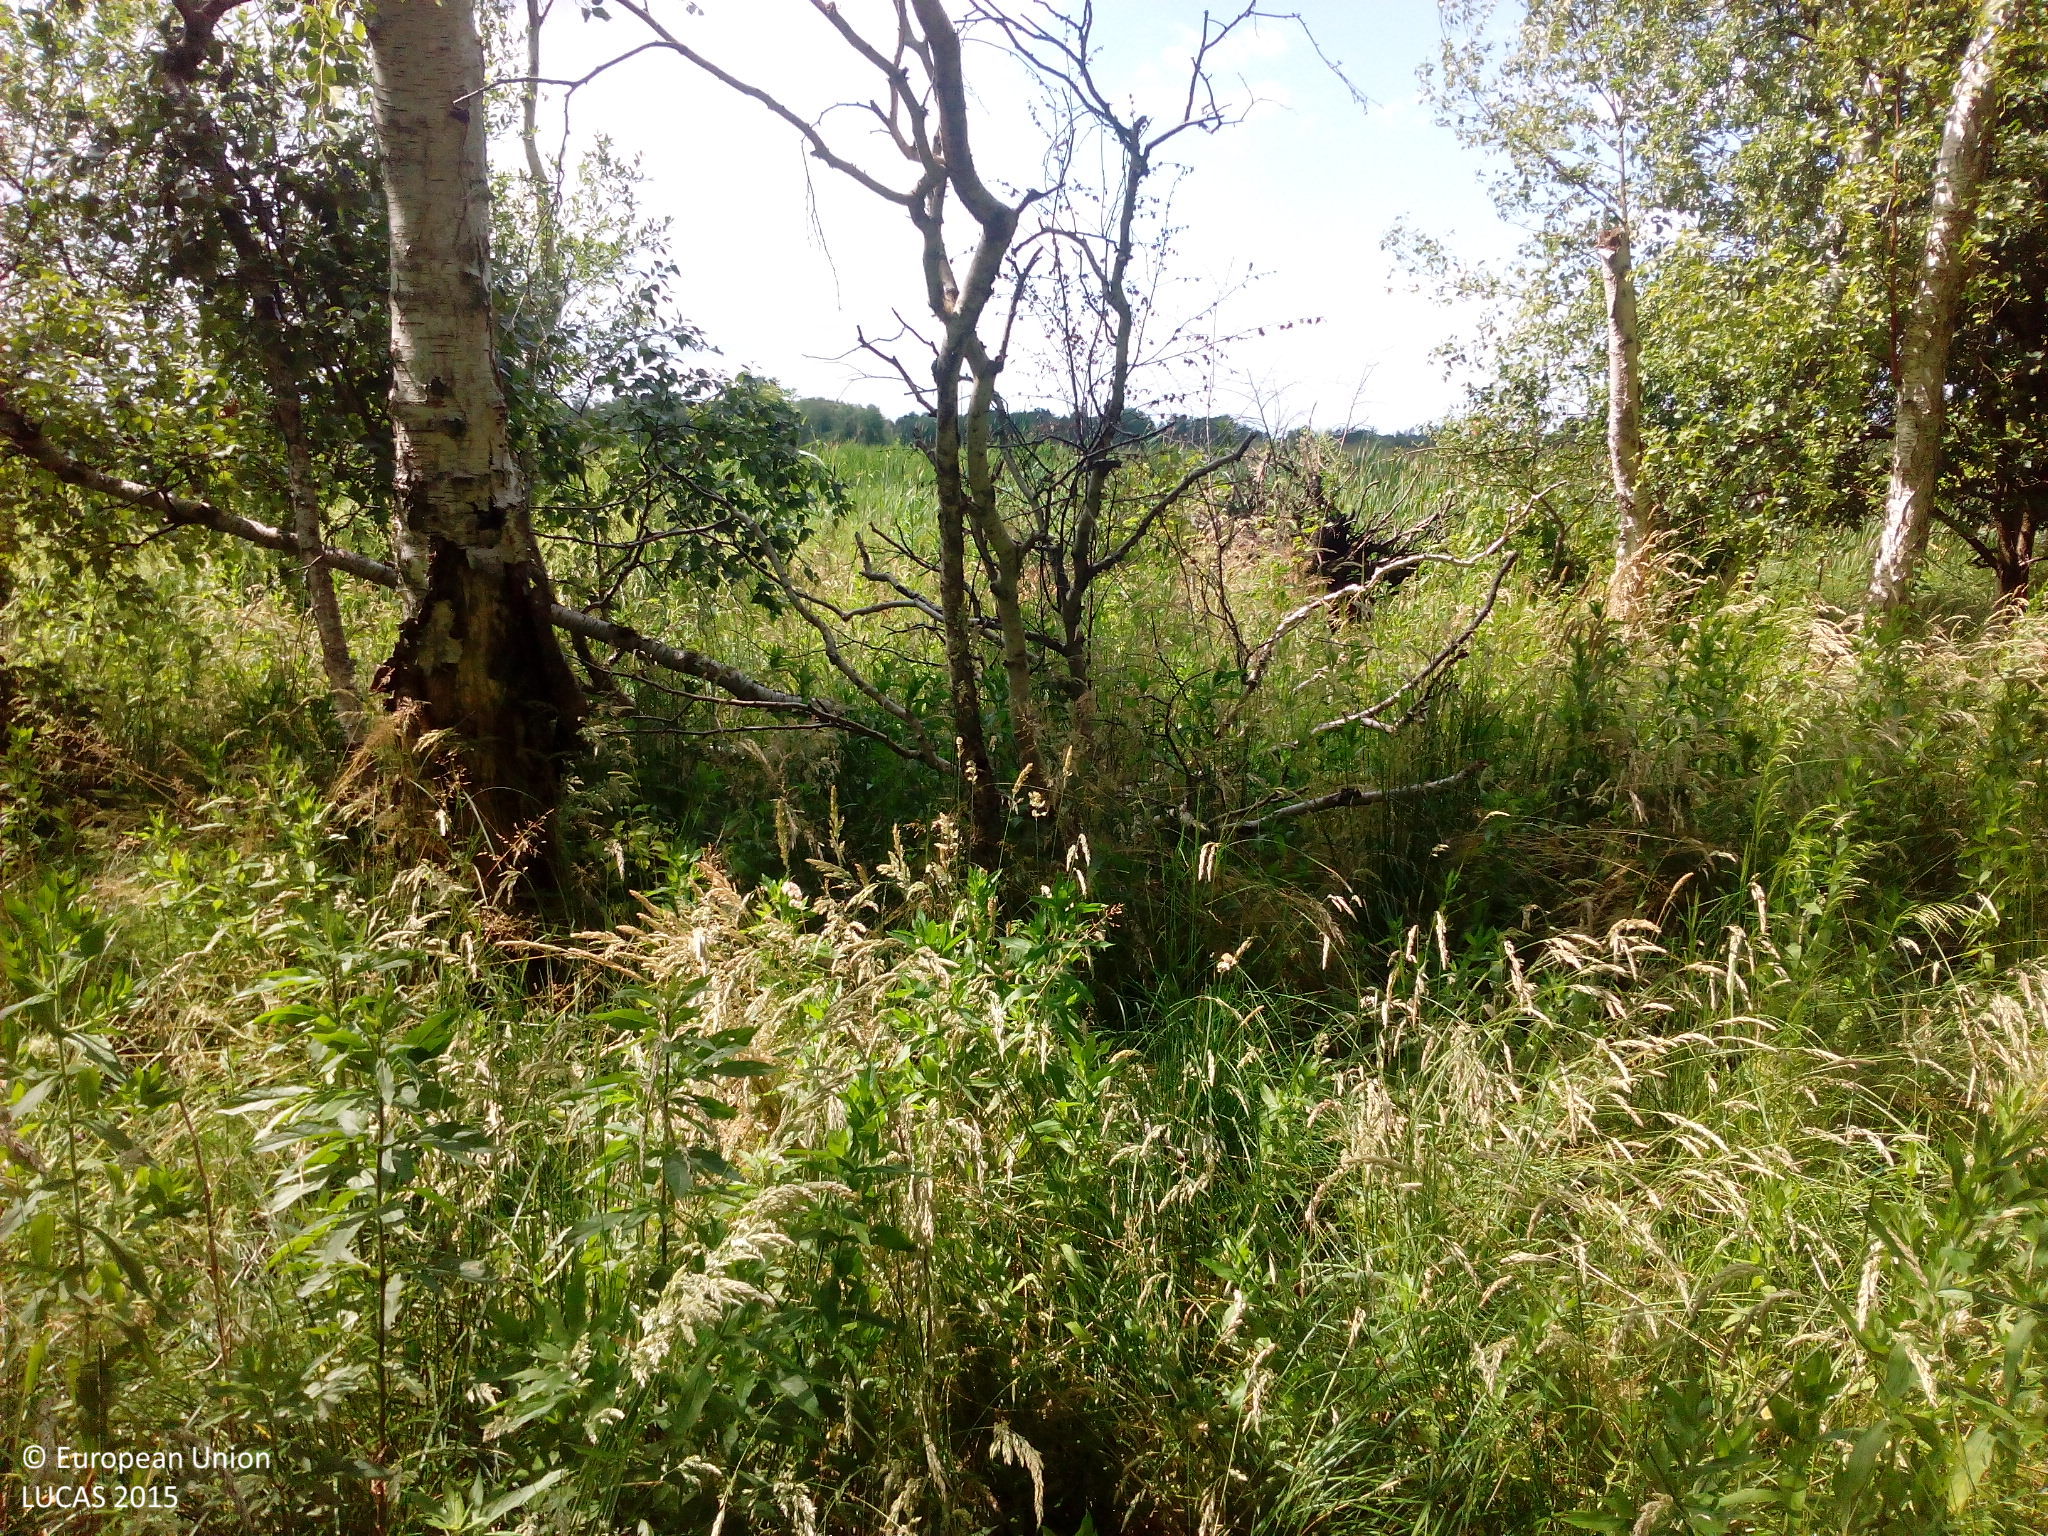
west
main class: Woodland
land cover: Broadleaved woodland
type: mesophytic deciduous forest
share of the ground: > 75 %
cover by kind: broadleaved forest trees 80 %, herbaceous plants 15 %, shrubs 5 %
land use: Semi-natural and natural areas not in use
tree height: > 5 m
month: July
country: DE
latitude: 53.9692
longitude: 13.2769
